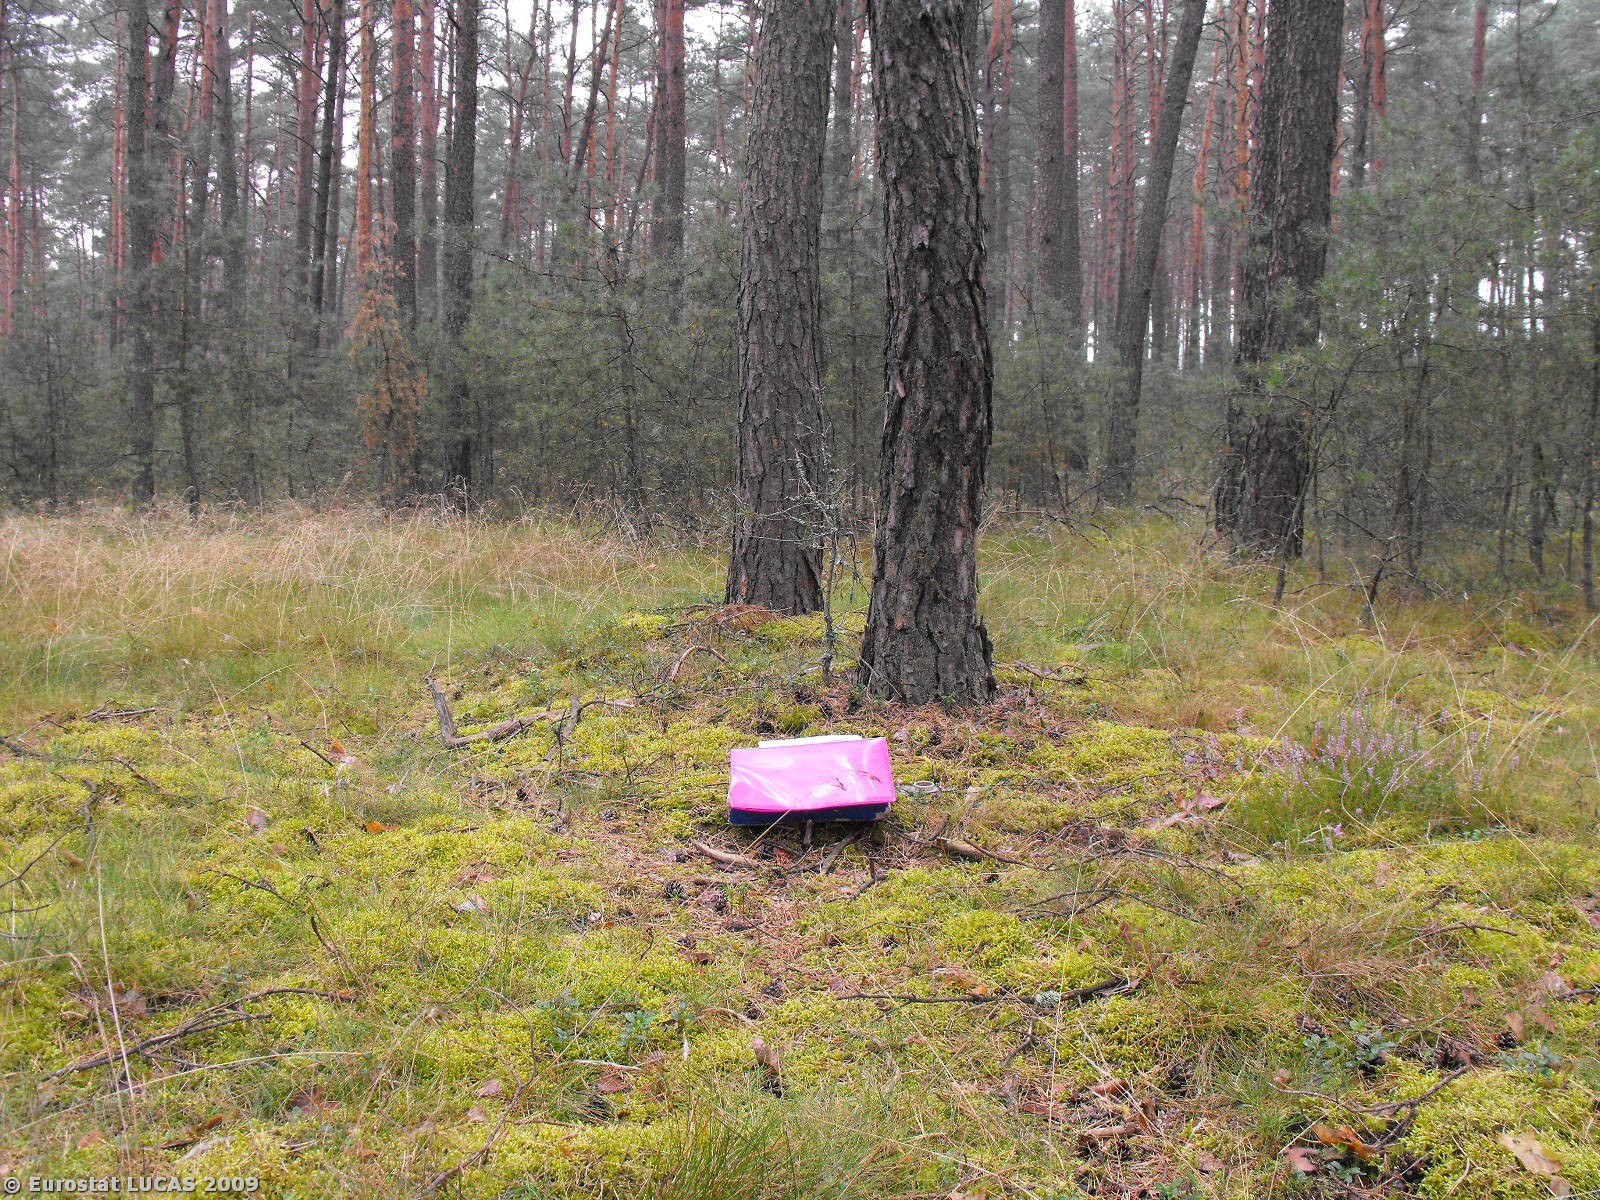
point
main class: Woodland
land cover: Coniferous woodland
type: hemiboreal forest and nemoral coniferous forest and mixed broadleaved-coniferous forest
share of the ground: > 75 %
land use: Forestry
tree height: > 5 m
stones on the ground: < 10 %
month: September
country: PL
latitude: 52.9430
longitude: 16.4206
